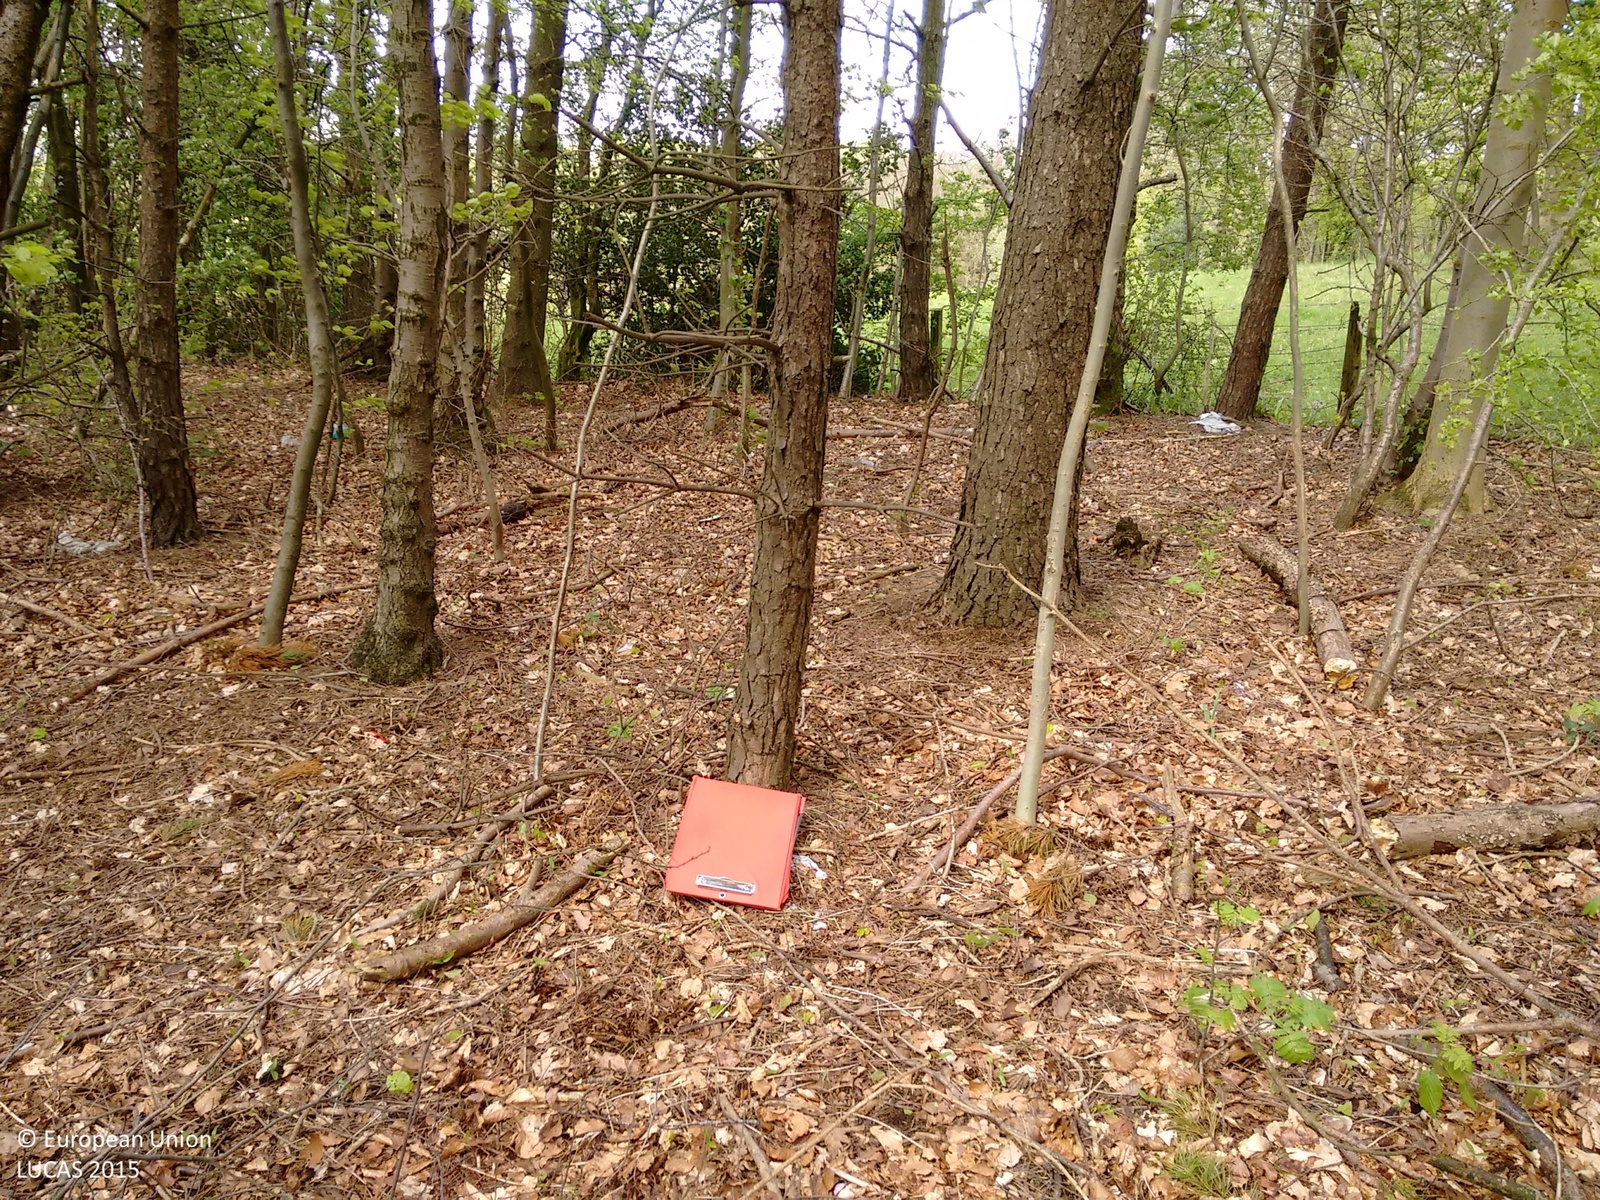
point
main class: Woodland
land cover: Broadleaved woodland
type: exotic forest
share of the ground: > 75 %
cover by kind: broadleaved forest trees 90 %, coniferous forest trees 10 %
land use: Amenities, museums, leisure
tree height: > 5 m
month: May
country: GB
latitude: 55.9695
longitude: -3.9454
